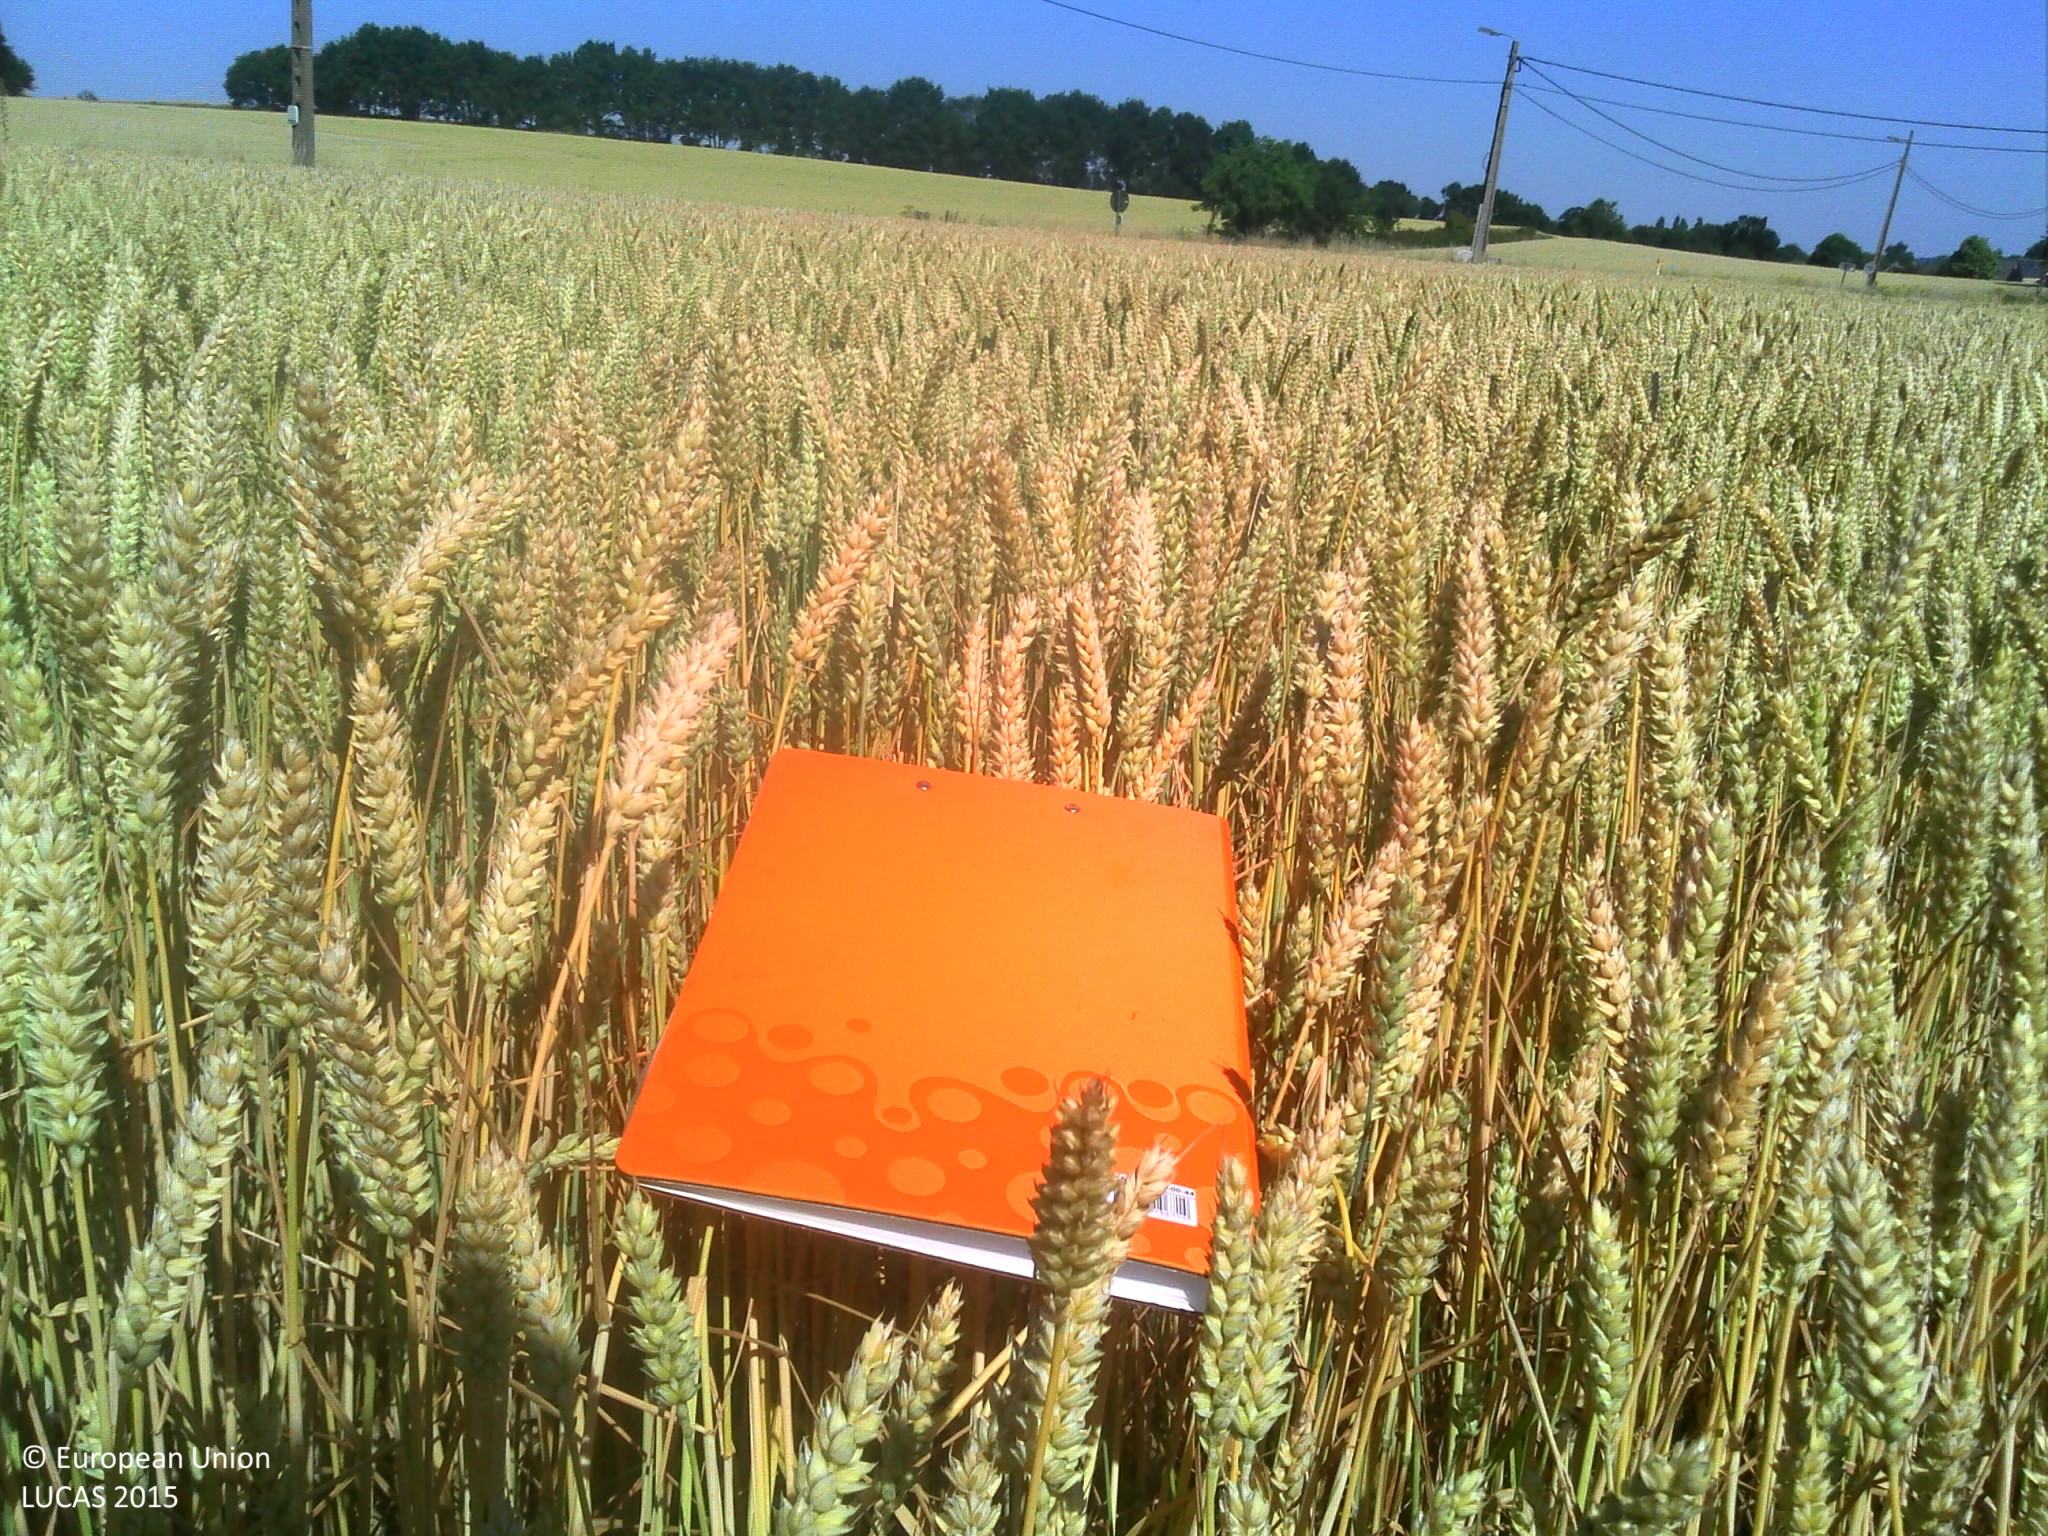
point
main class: Cropland
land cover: Common wheat
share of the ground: > 75 %
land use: Agriculture (excluding fallow land and kitchen gardens)
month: July
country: BE
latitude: 50.8205
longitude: 4.7586
